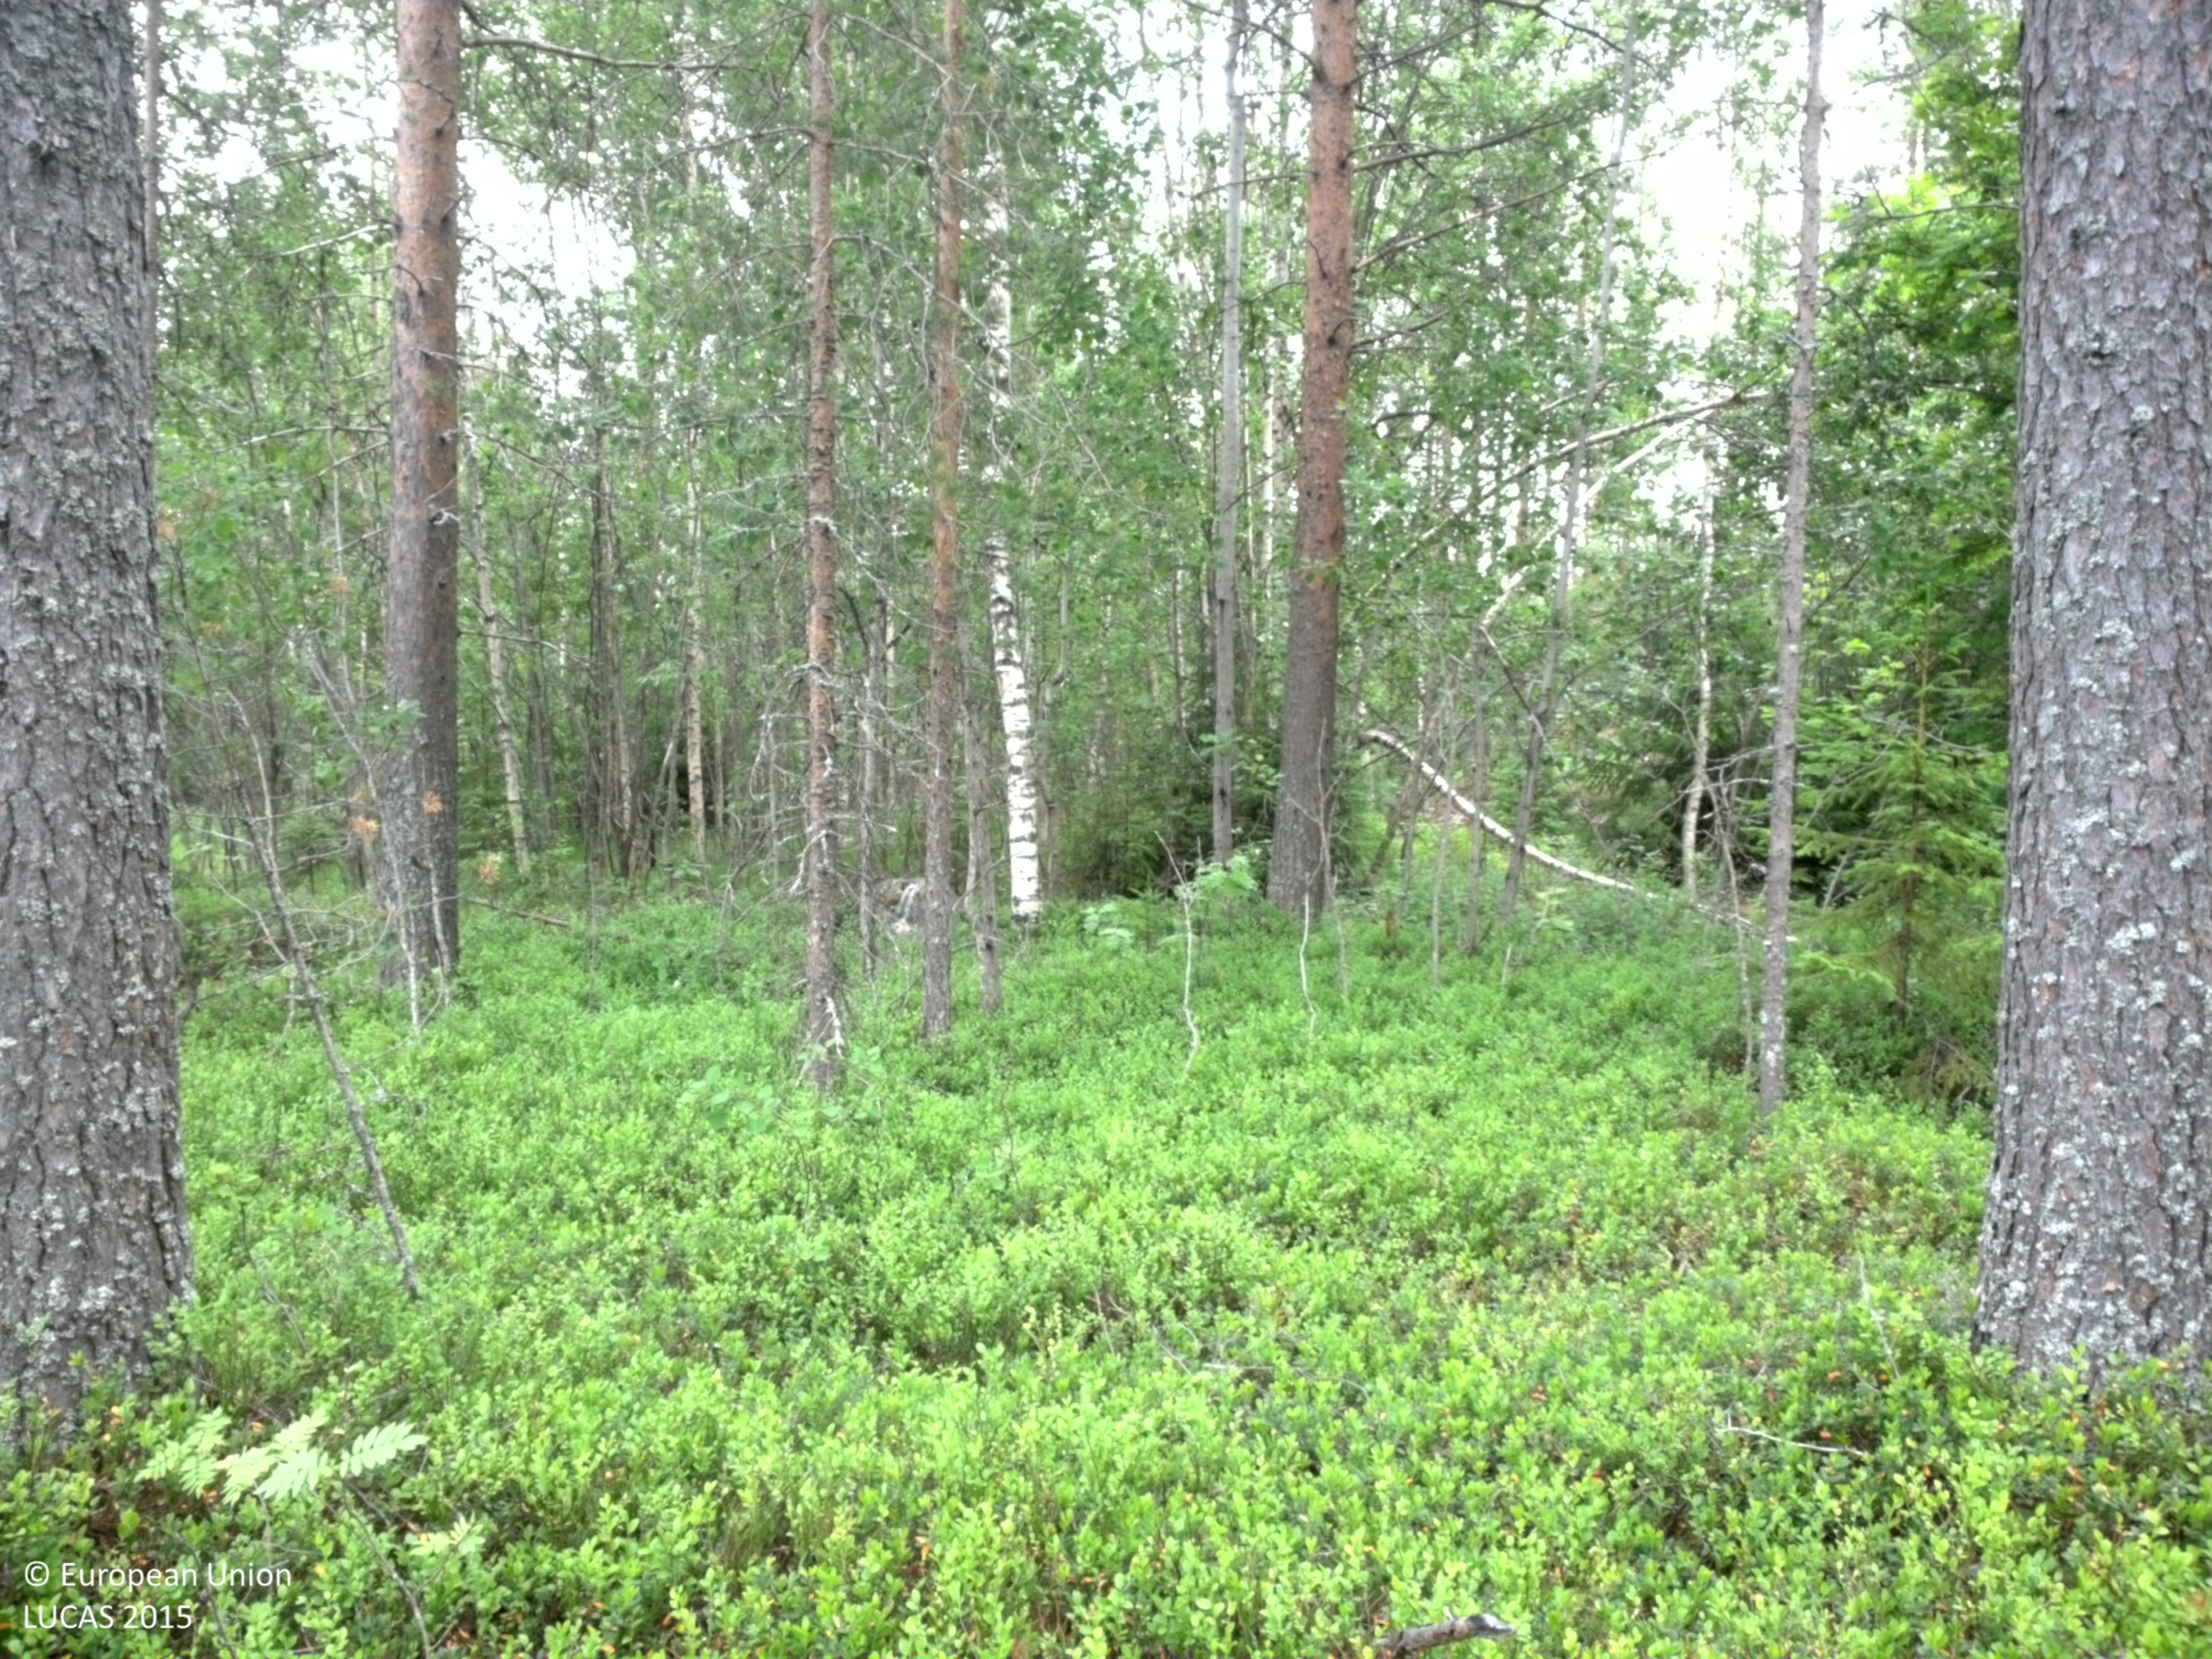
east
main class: Woodland
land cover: Pine dominated coniferous woodland
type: boreal forest
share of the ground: 25 - 50 %
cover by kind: shrubs 65 %, coniferous forest trees 30 %, broadleaved forest trees 5 %
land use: Forestry
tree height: > 5 m
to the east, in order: Pine dominated coniferous woodland; Paved roads, cycling and walking lanes; Tracks; Pine dominated coniferous woodland; Grassland without tree/shrub cover; Pine dominated mixed woodland; Pine dominated coniferous woodland; Rye; Ditches and canals; Pine dominated mixed woodland; Broadleaved woodland
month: July
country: SE
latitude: 64.4962
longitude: 20.9084
